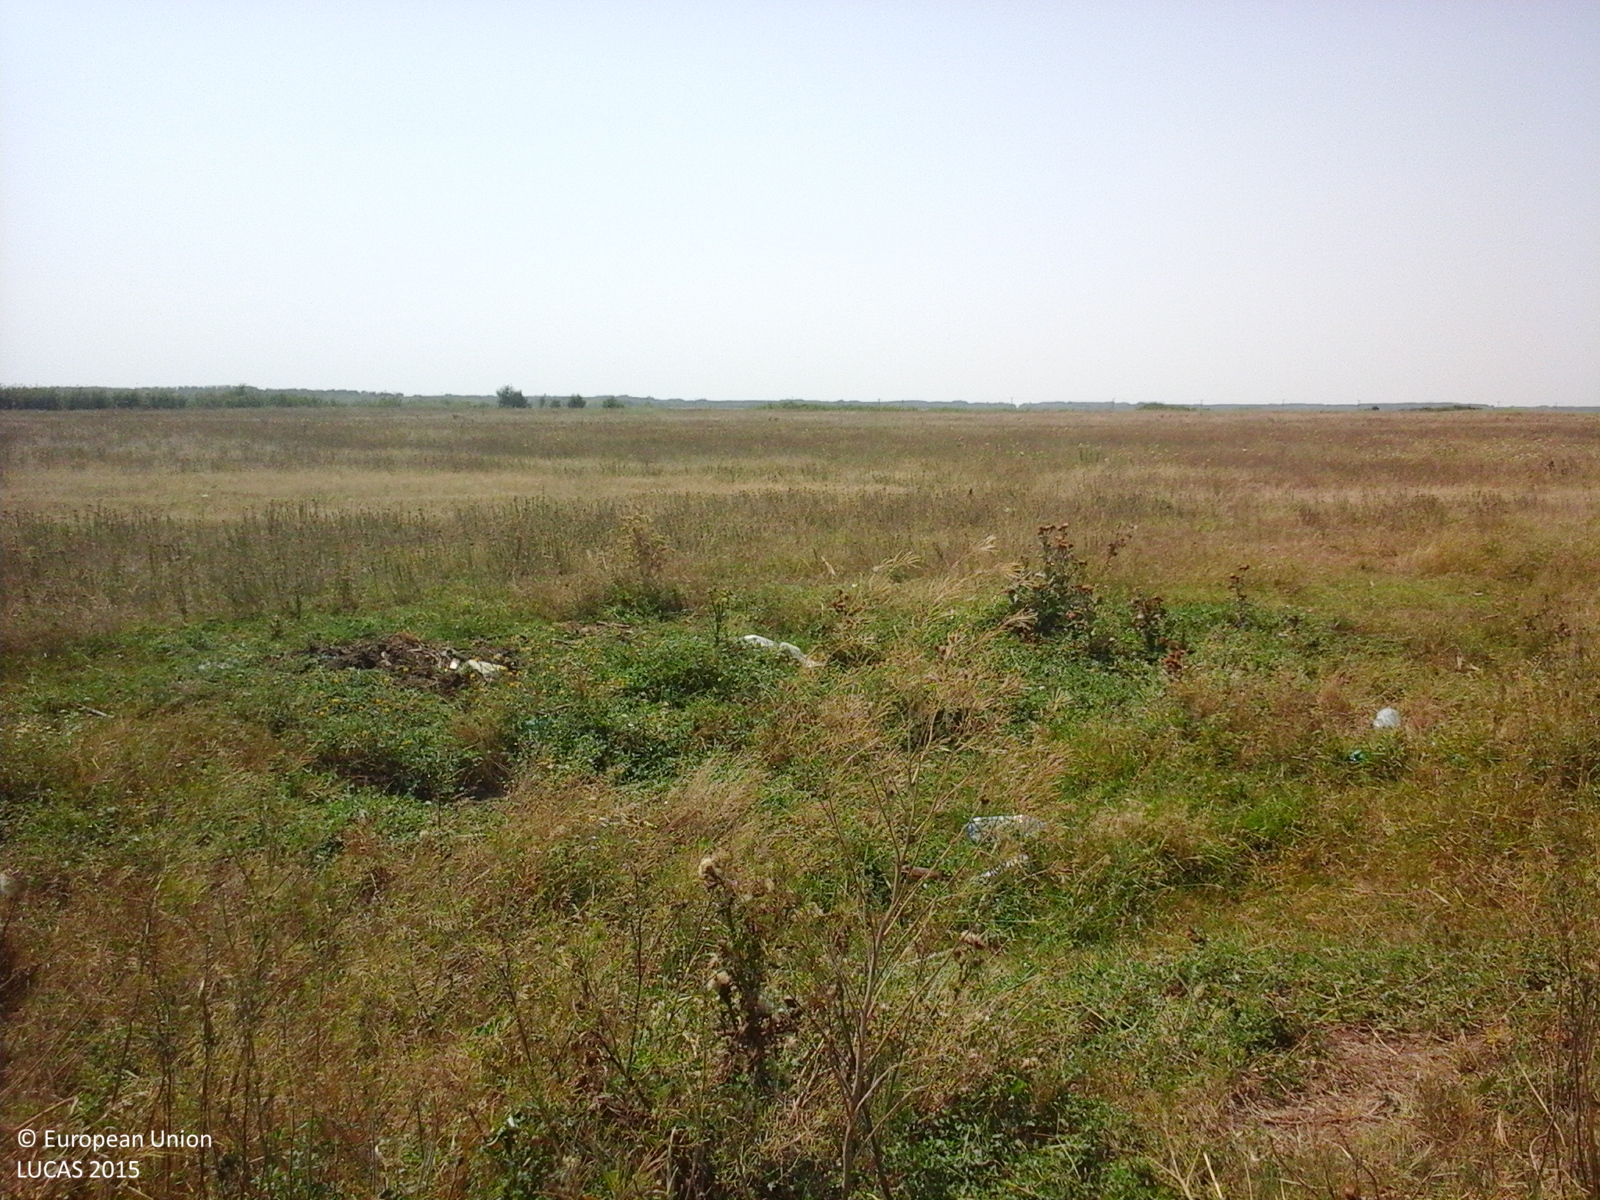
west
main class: Grassland
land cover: Spontaneously vegetated surfaces
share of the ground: > 75 %
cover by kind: herbaceous plants 100 %
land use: Fallow land
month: July
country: RO
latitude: 45.4558
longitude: 27.7699
